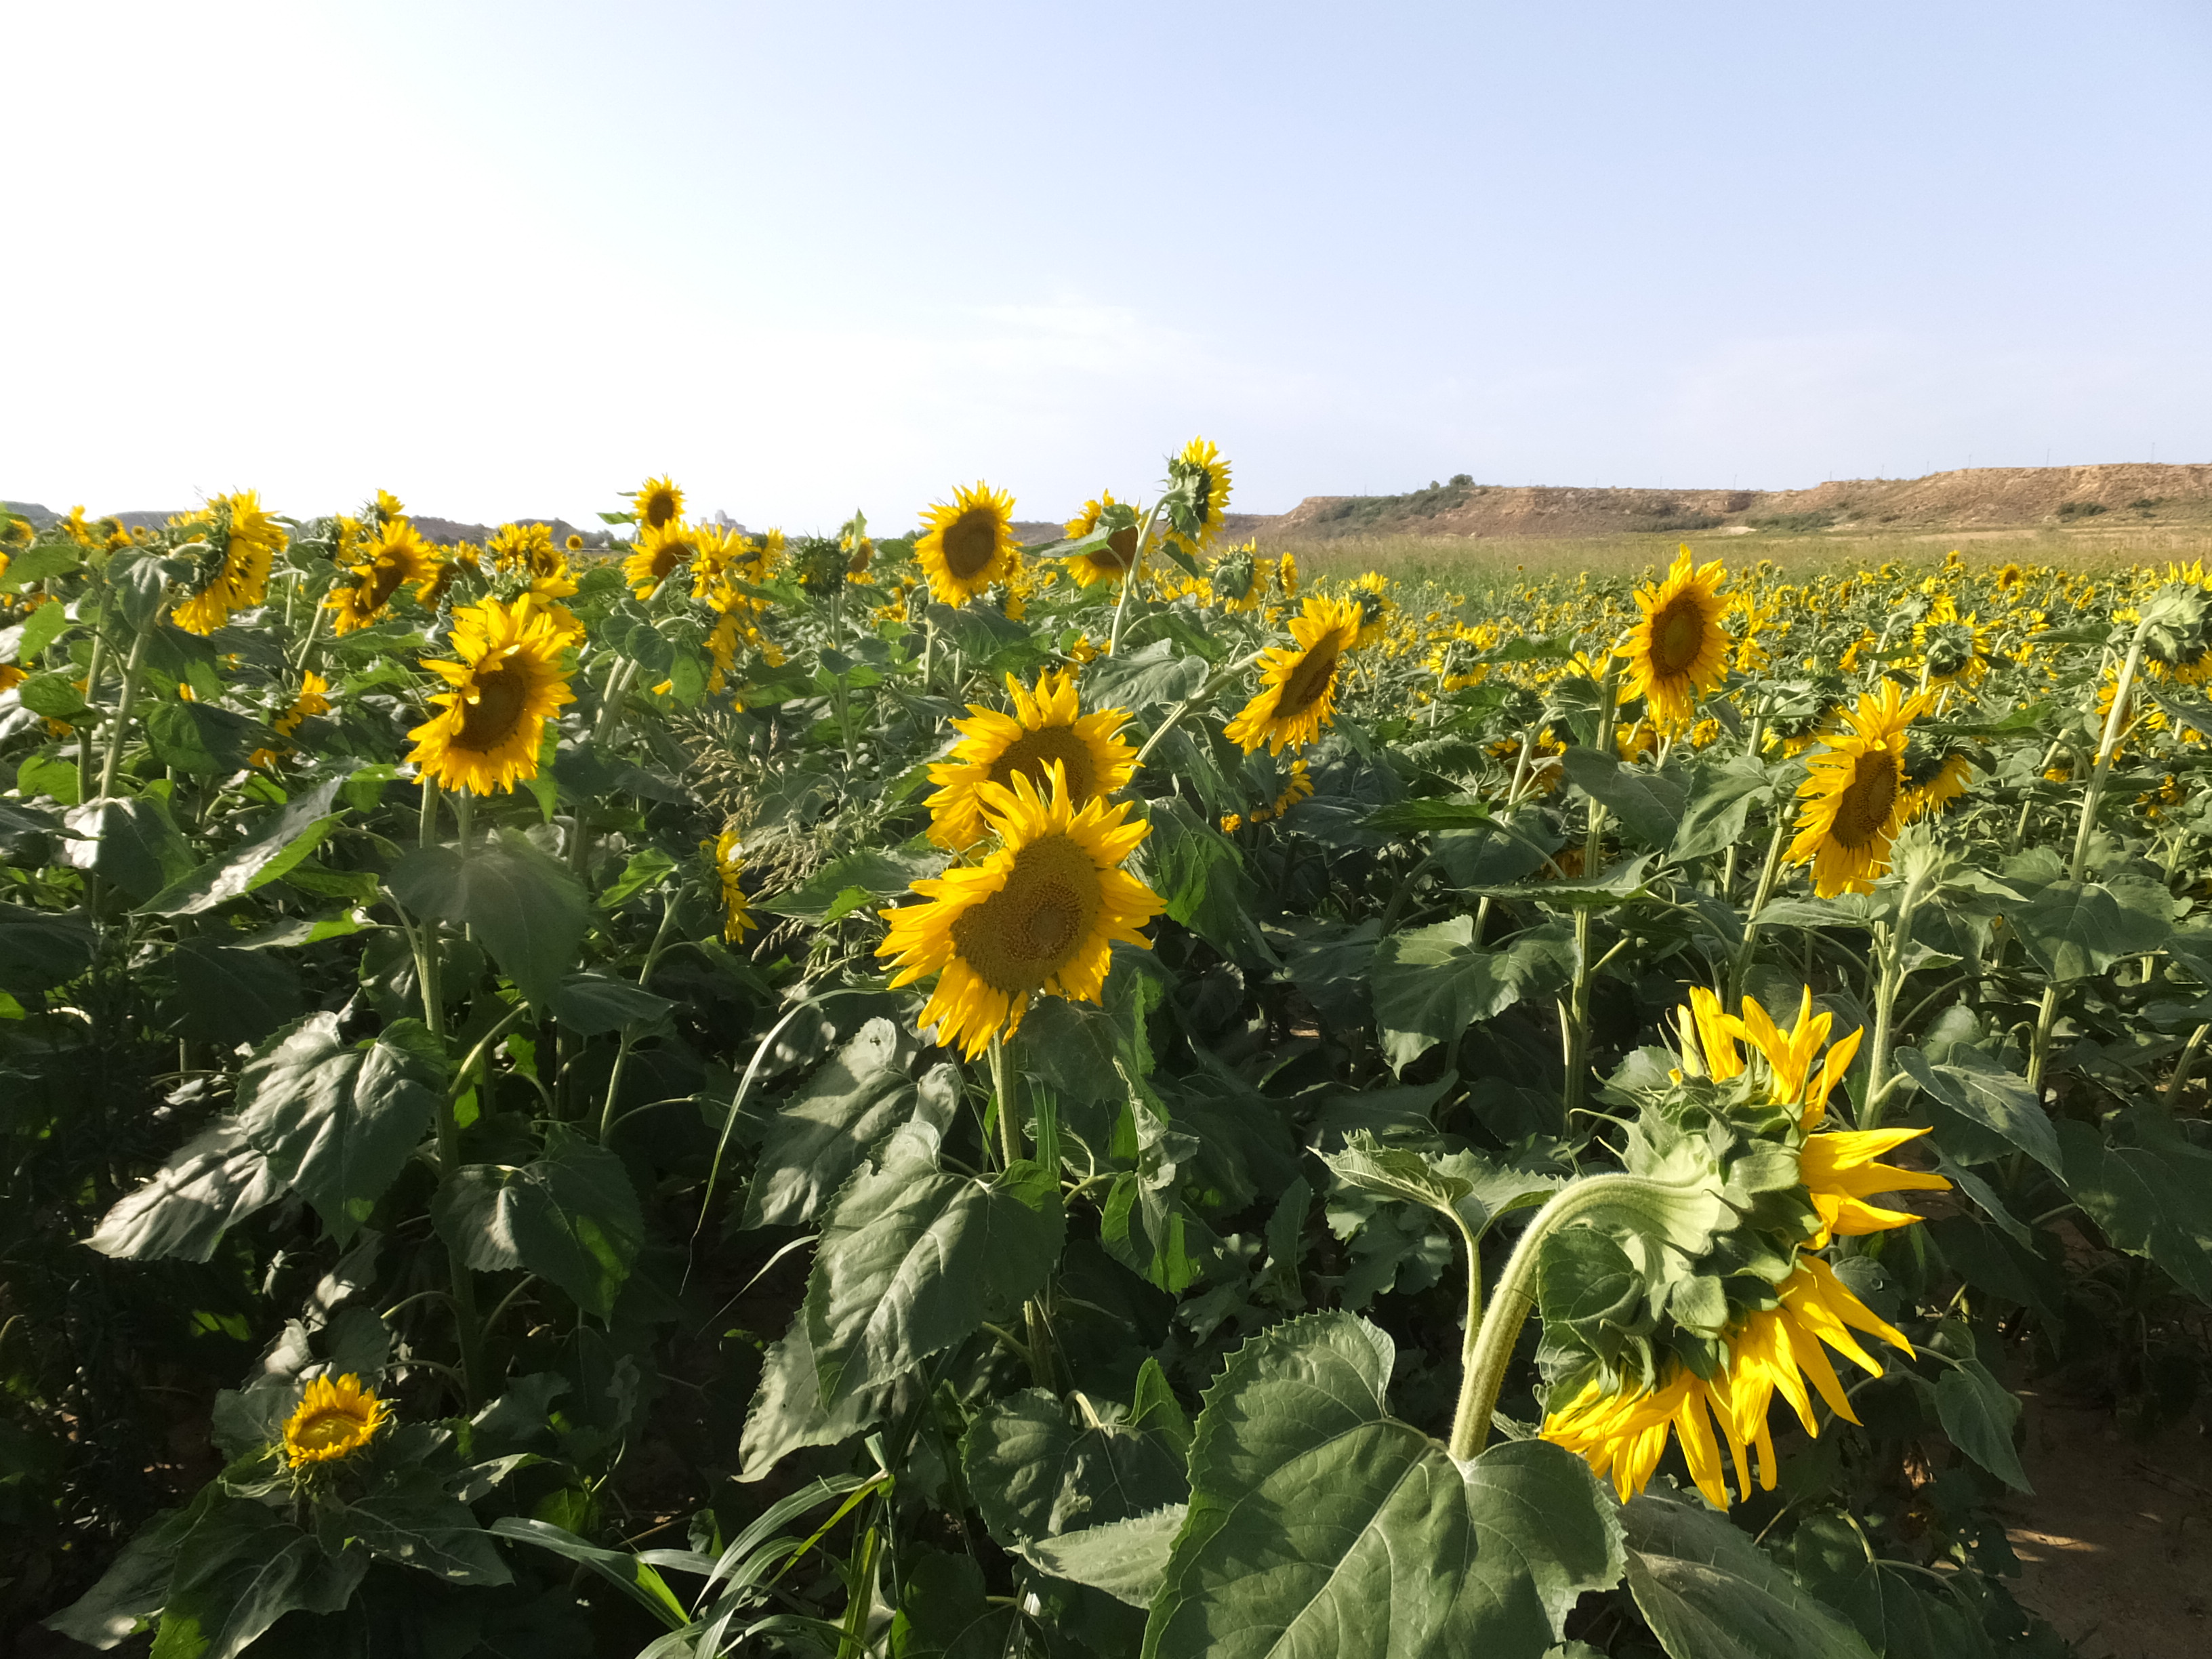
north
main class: Cropland
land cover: Sunflower
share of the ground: > 75 %
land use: Agriculture (excluding fallow land and kitchen gardens)
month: July
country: ES
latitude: 41.7445
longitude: 0.2326
